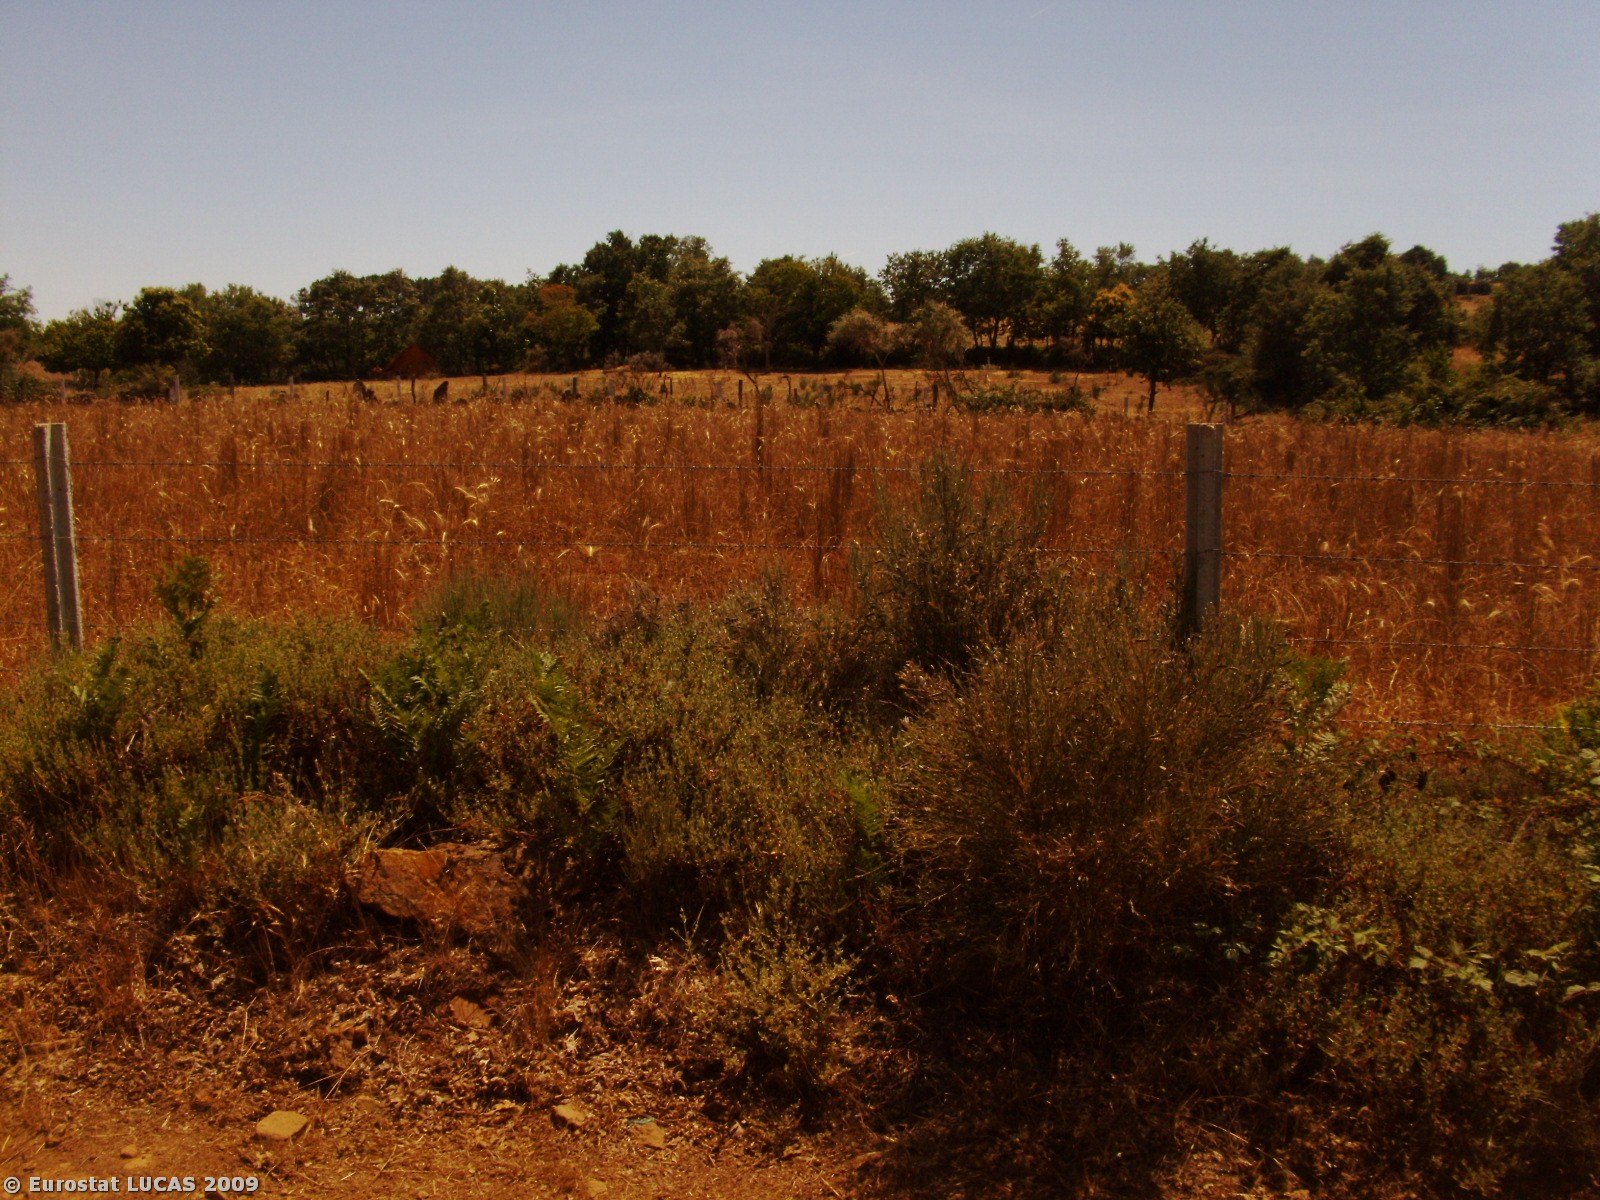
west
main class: Grassland
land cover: Spontaneously vegetated surfaces
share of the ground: > 75 %
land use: Fallow land
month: July
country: PT
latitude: 40.3446
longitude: -6.9657
